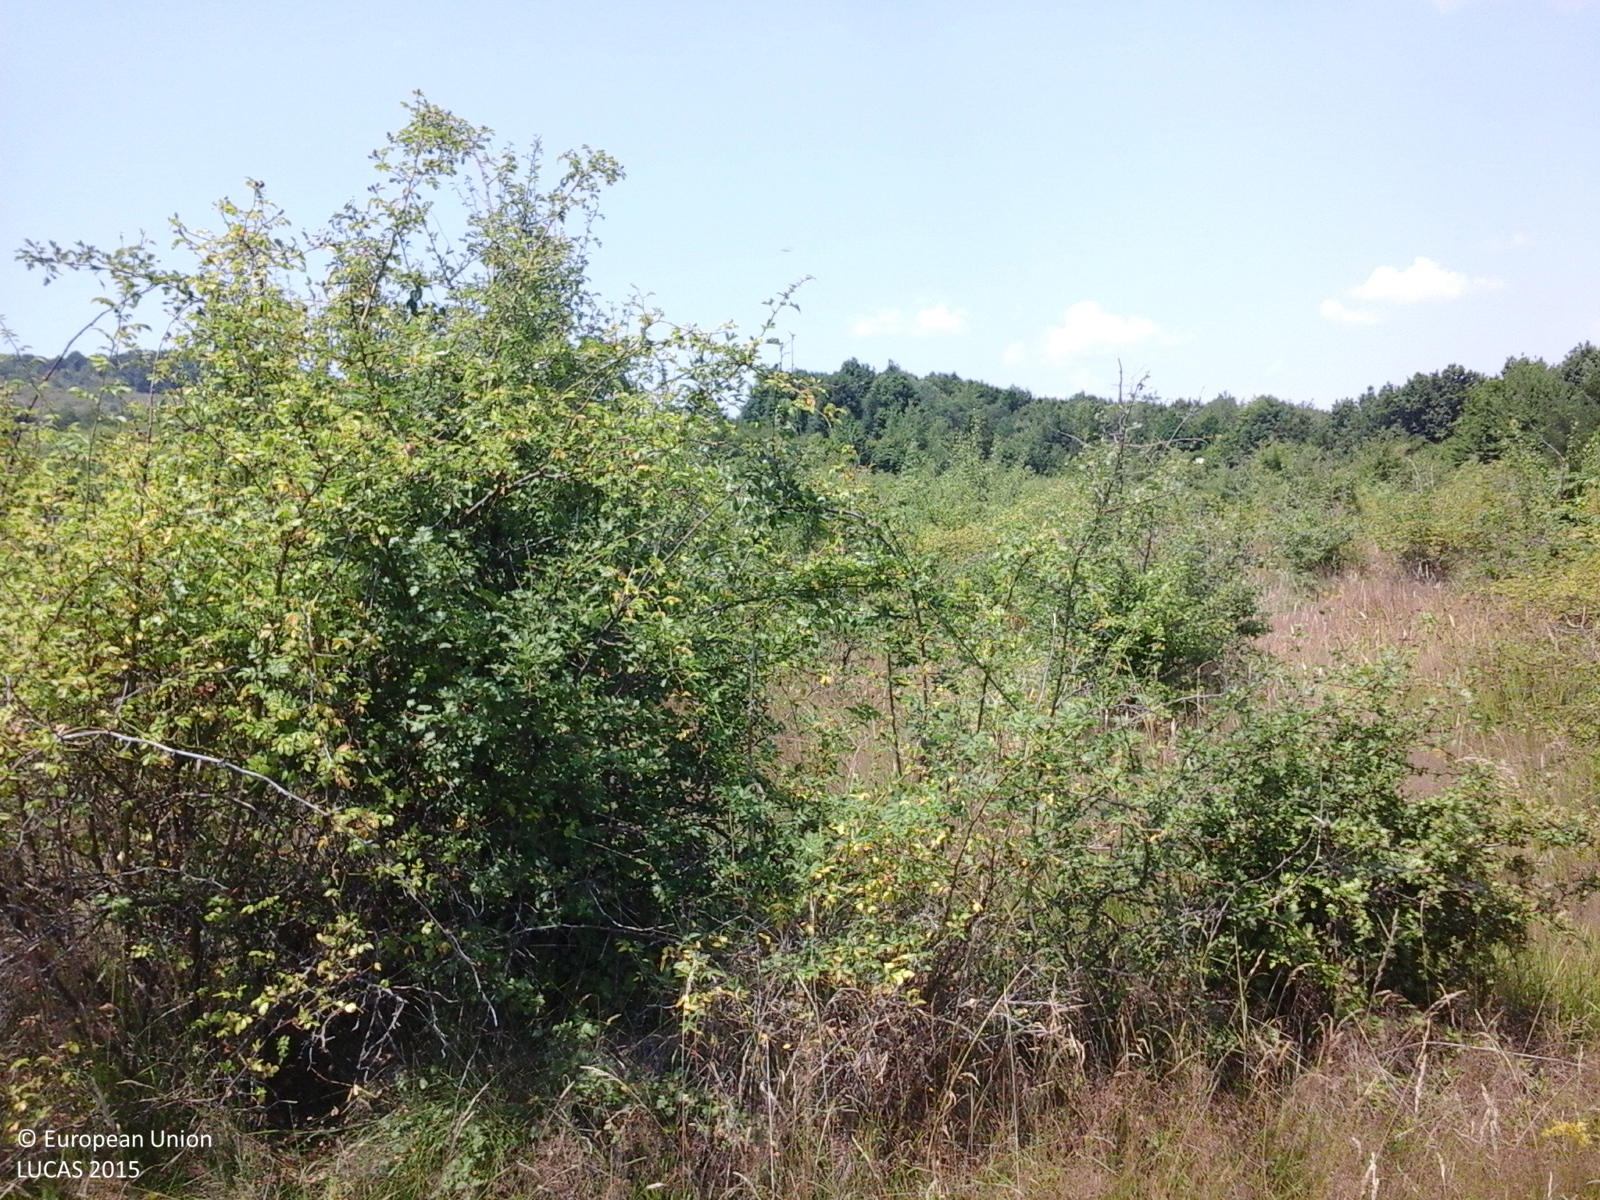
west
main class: Shrubland
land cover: Shrubland with sparse tree cover
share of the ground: > 75 %
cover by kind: shrubs 80 %, herbaceous plants 15 %, broadleaved forest trees 5 %
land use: Semi-natural and natural areas not in use
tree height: < 5 m
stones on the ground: < 10 %
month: July
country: RO
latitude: 45.0197
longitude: 24.6857
